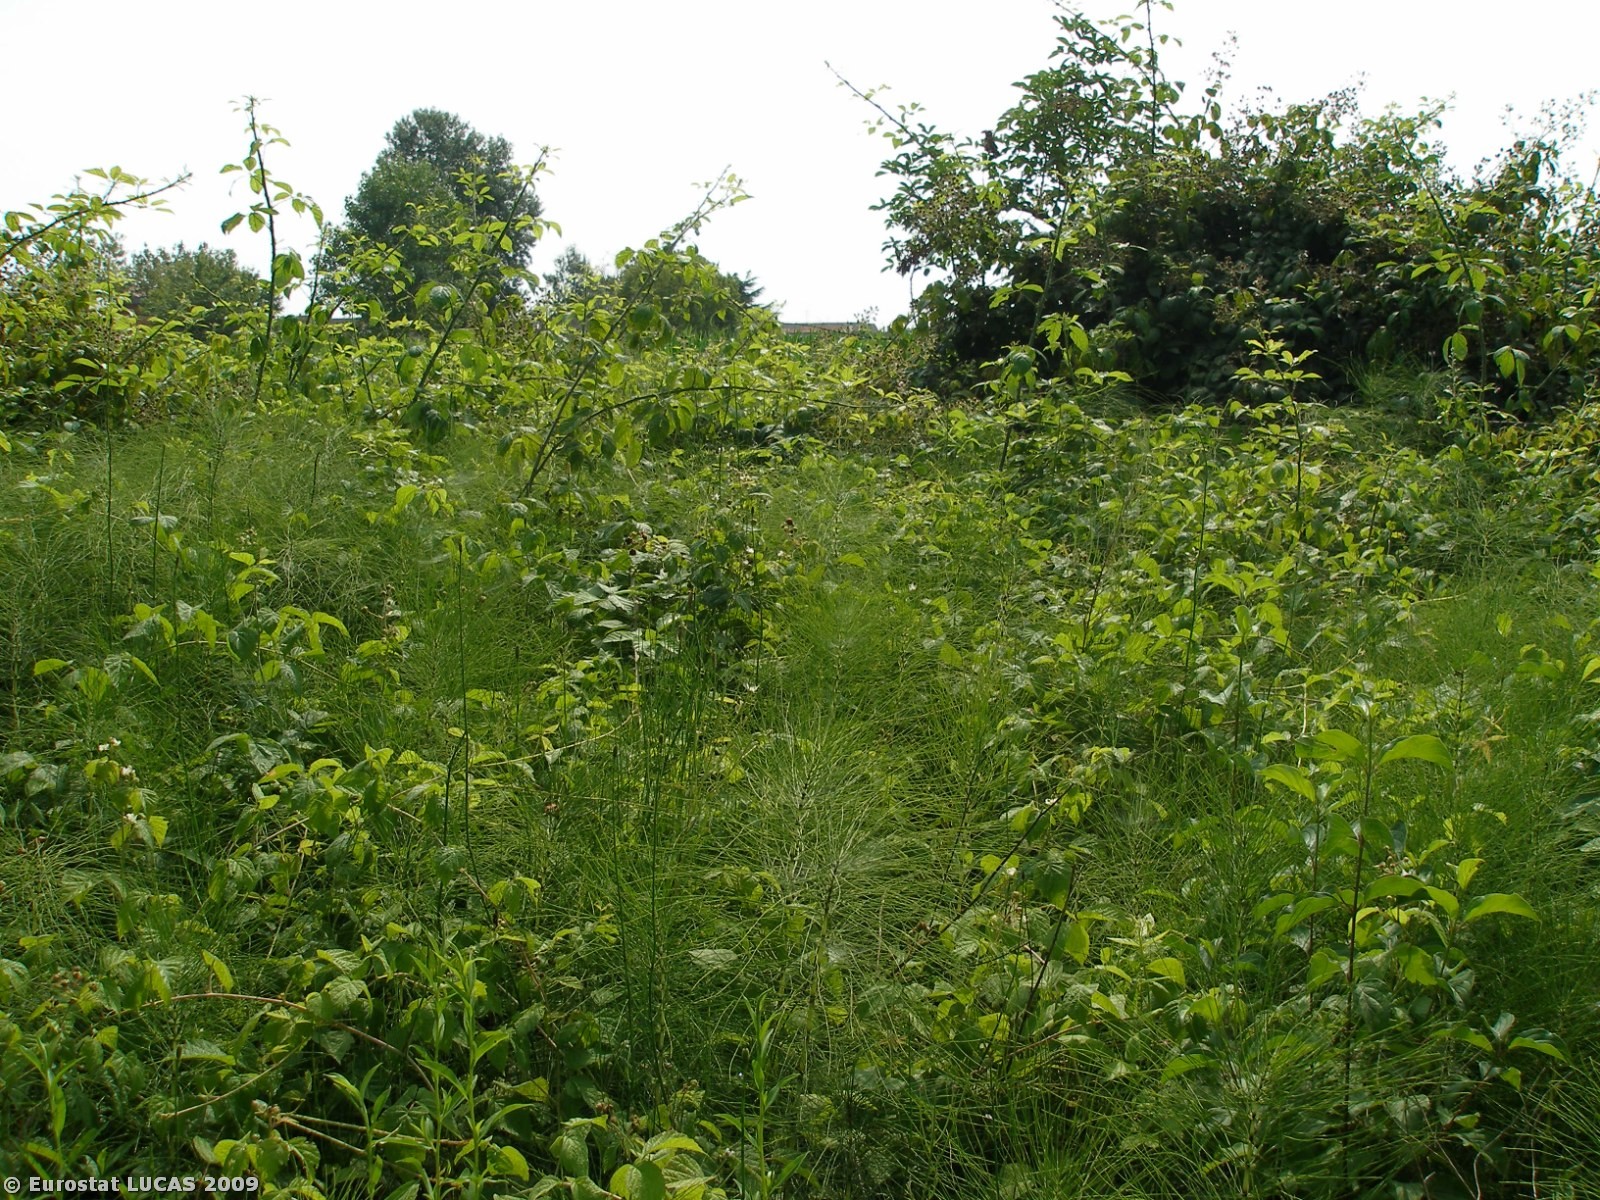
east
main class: Grassland
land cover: Spontaneously vegetated surfaces
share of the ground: > 75 %
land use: Unused
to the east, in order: Spontaneously vegetated surfaces; Shrubland with sparse tree cover; Bare land; Maize; Ditches and canals; Maize; Artificial constructions in urban areas; Maize; Grass margins; Ditches and canals; Grass margins; Single bushes/trees; Fences; Lucerne; Grass margins; Tracks; Fences; Artificial constructions in urban areas
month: July
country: IT
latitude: 44.9969
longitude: 12.0892
